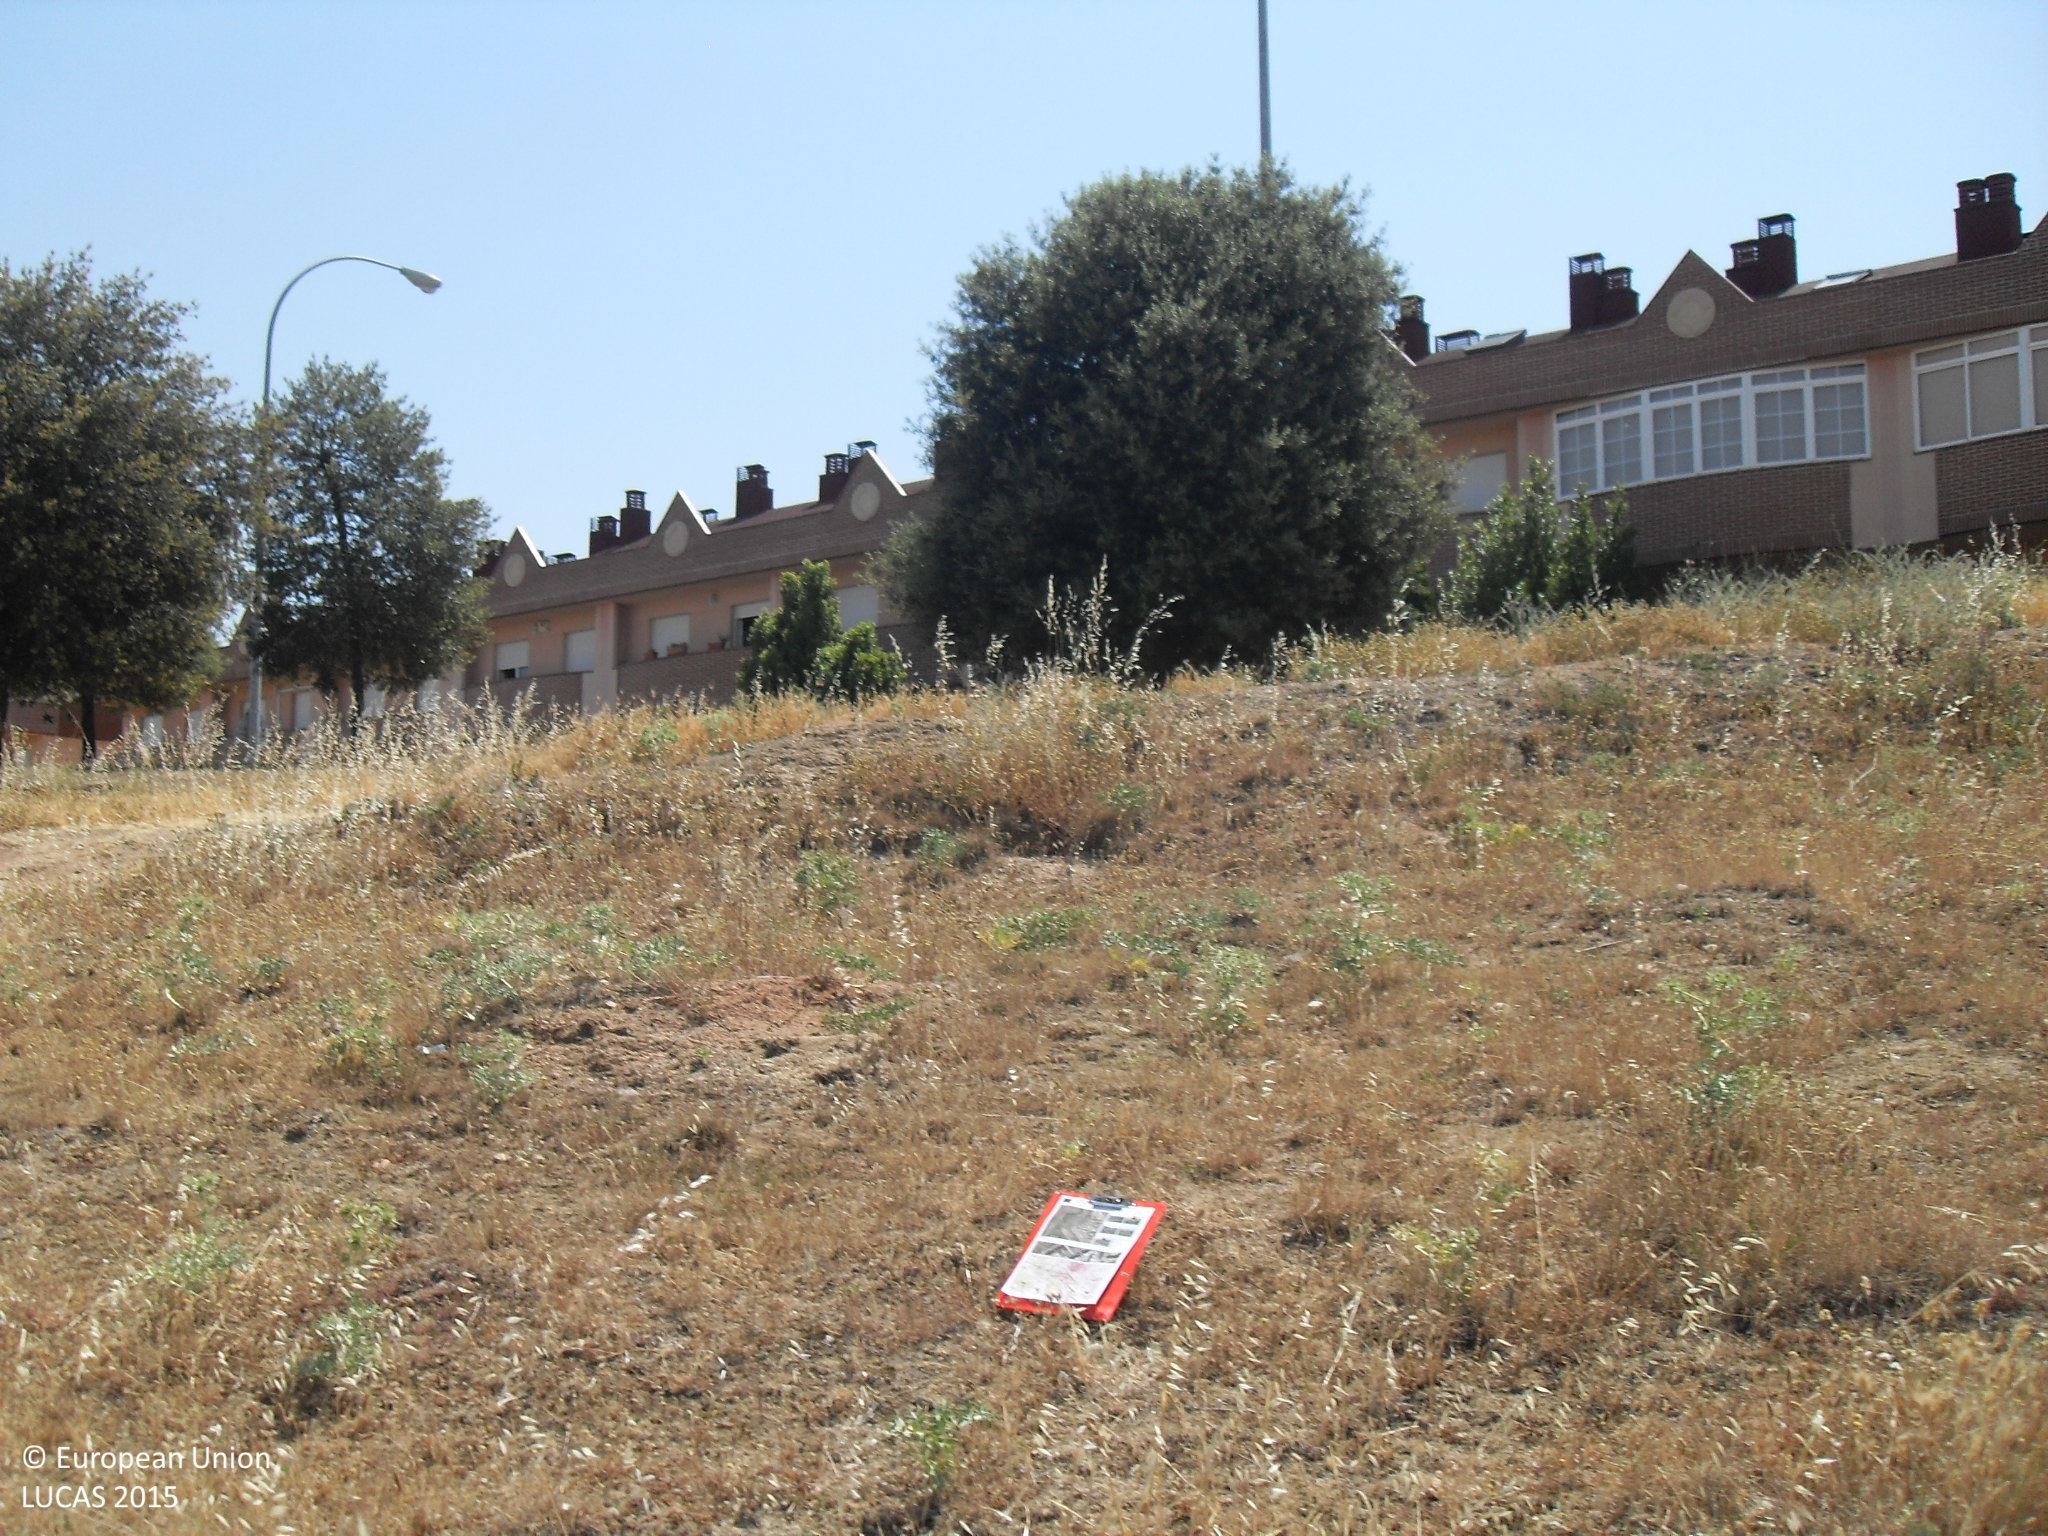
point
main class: Grassland
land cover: Grassland with sparse tree/shrub cover
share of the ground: > 75 %
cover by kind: herbaceous plants 95 %, coniferous forest trees 5 %
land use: Semi-natural and natural areas not in use
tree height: > 5 m
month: June
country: ES
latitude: 40.9473
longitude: -5.6743
